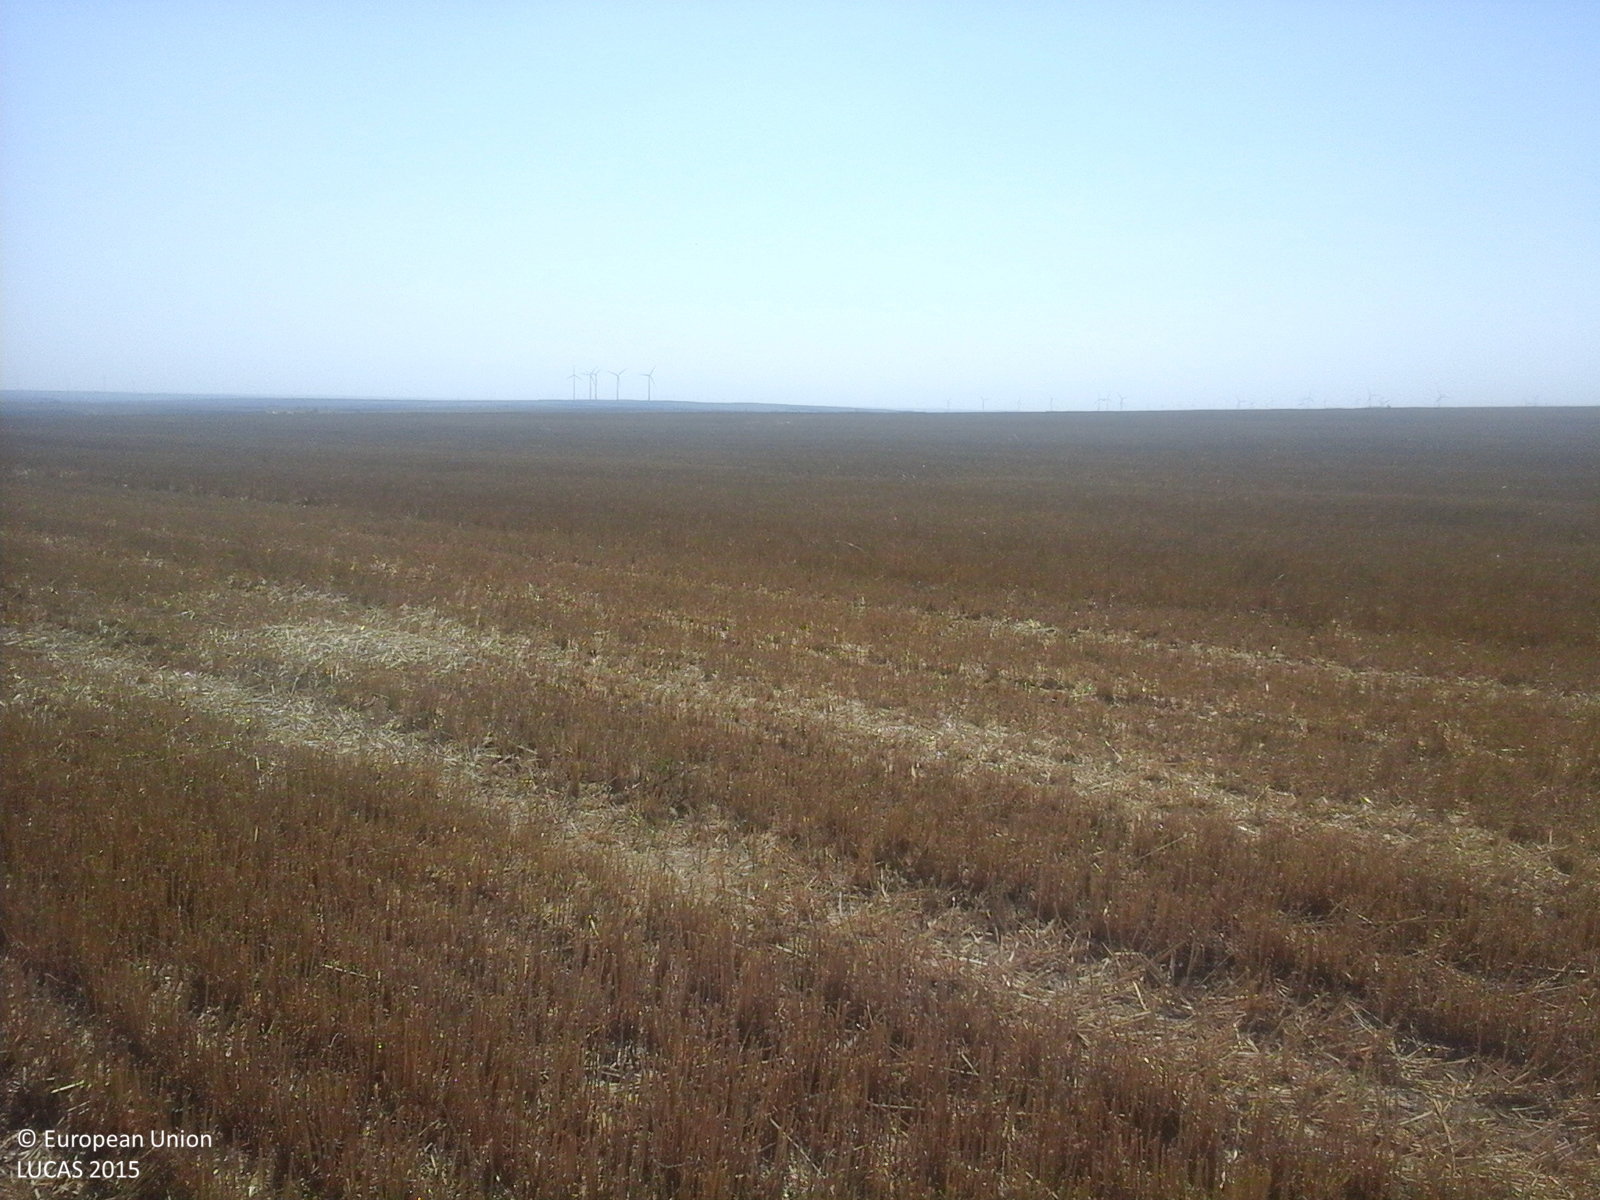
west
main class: Cropland
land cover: Common wheat
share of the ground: > 75 %
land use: Agriculture (excluding fallow land and kitchen gardens)
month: August
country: RO
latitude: 44.4240
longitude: 28.3950
